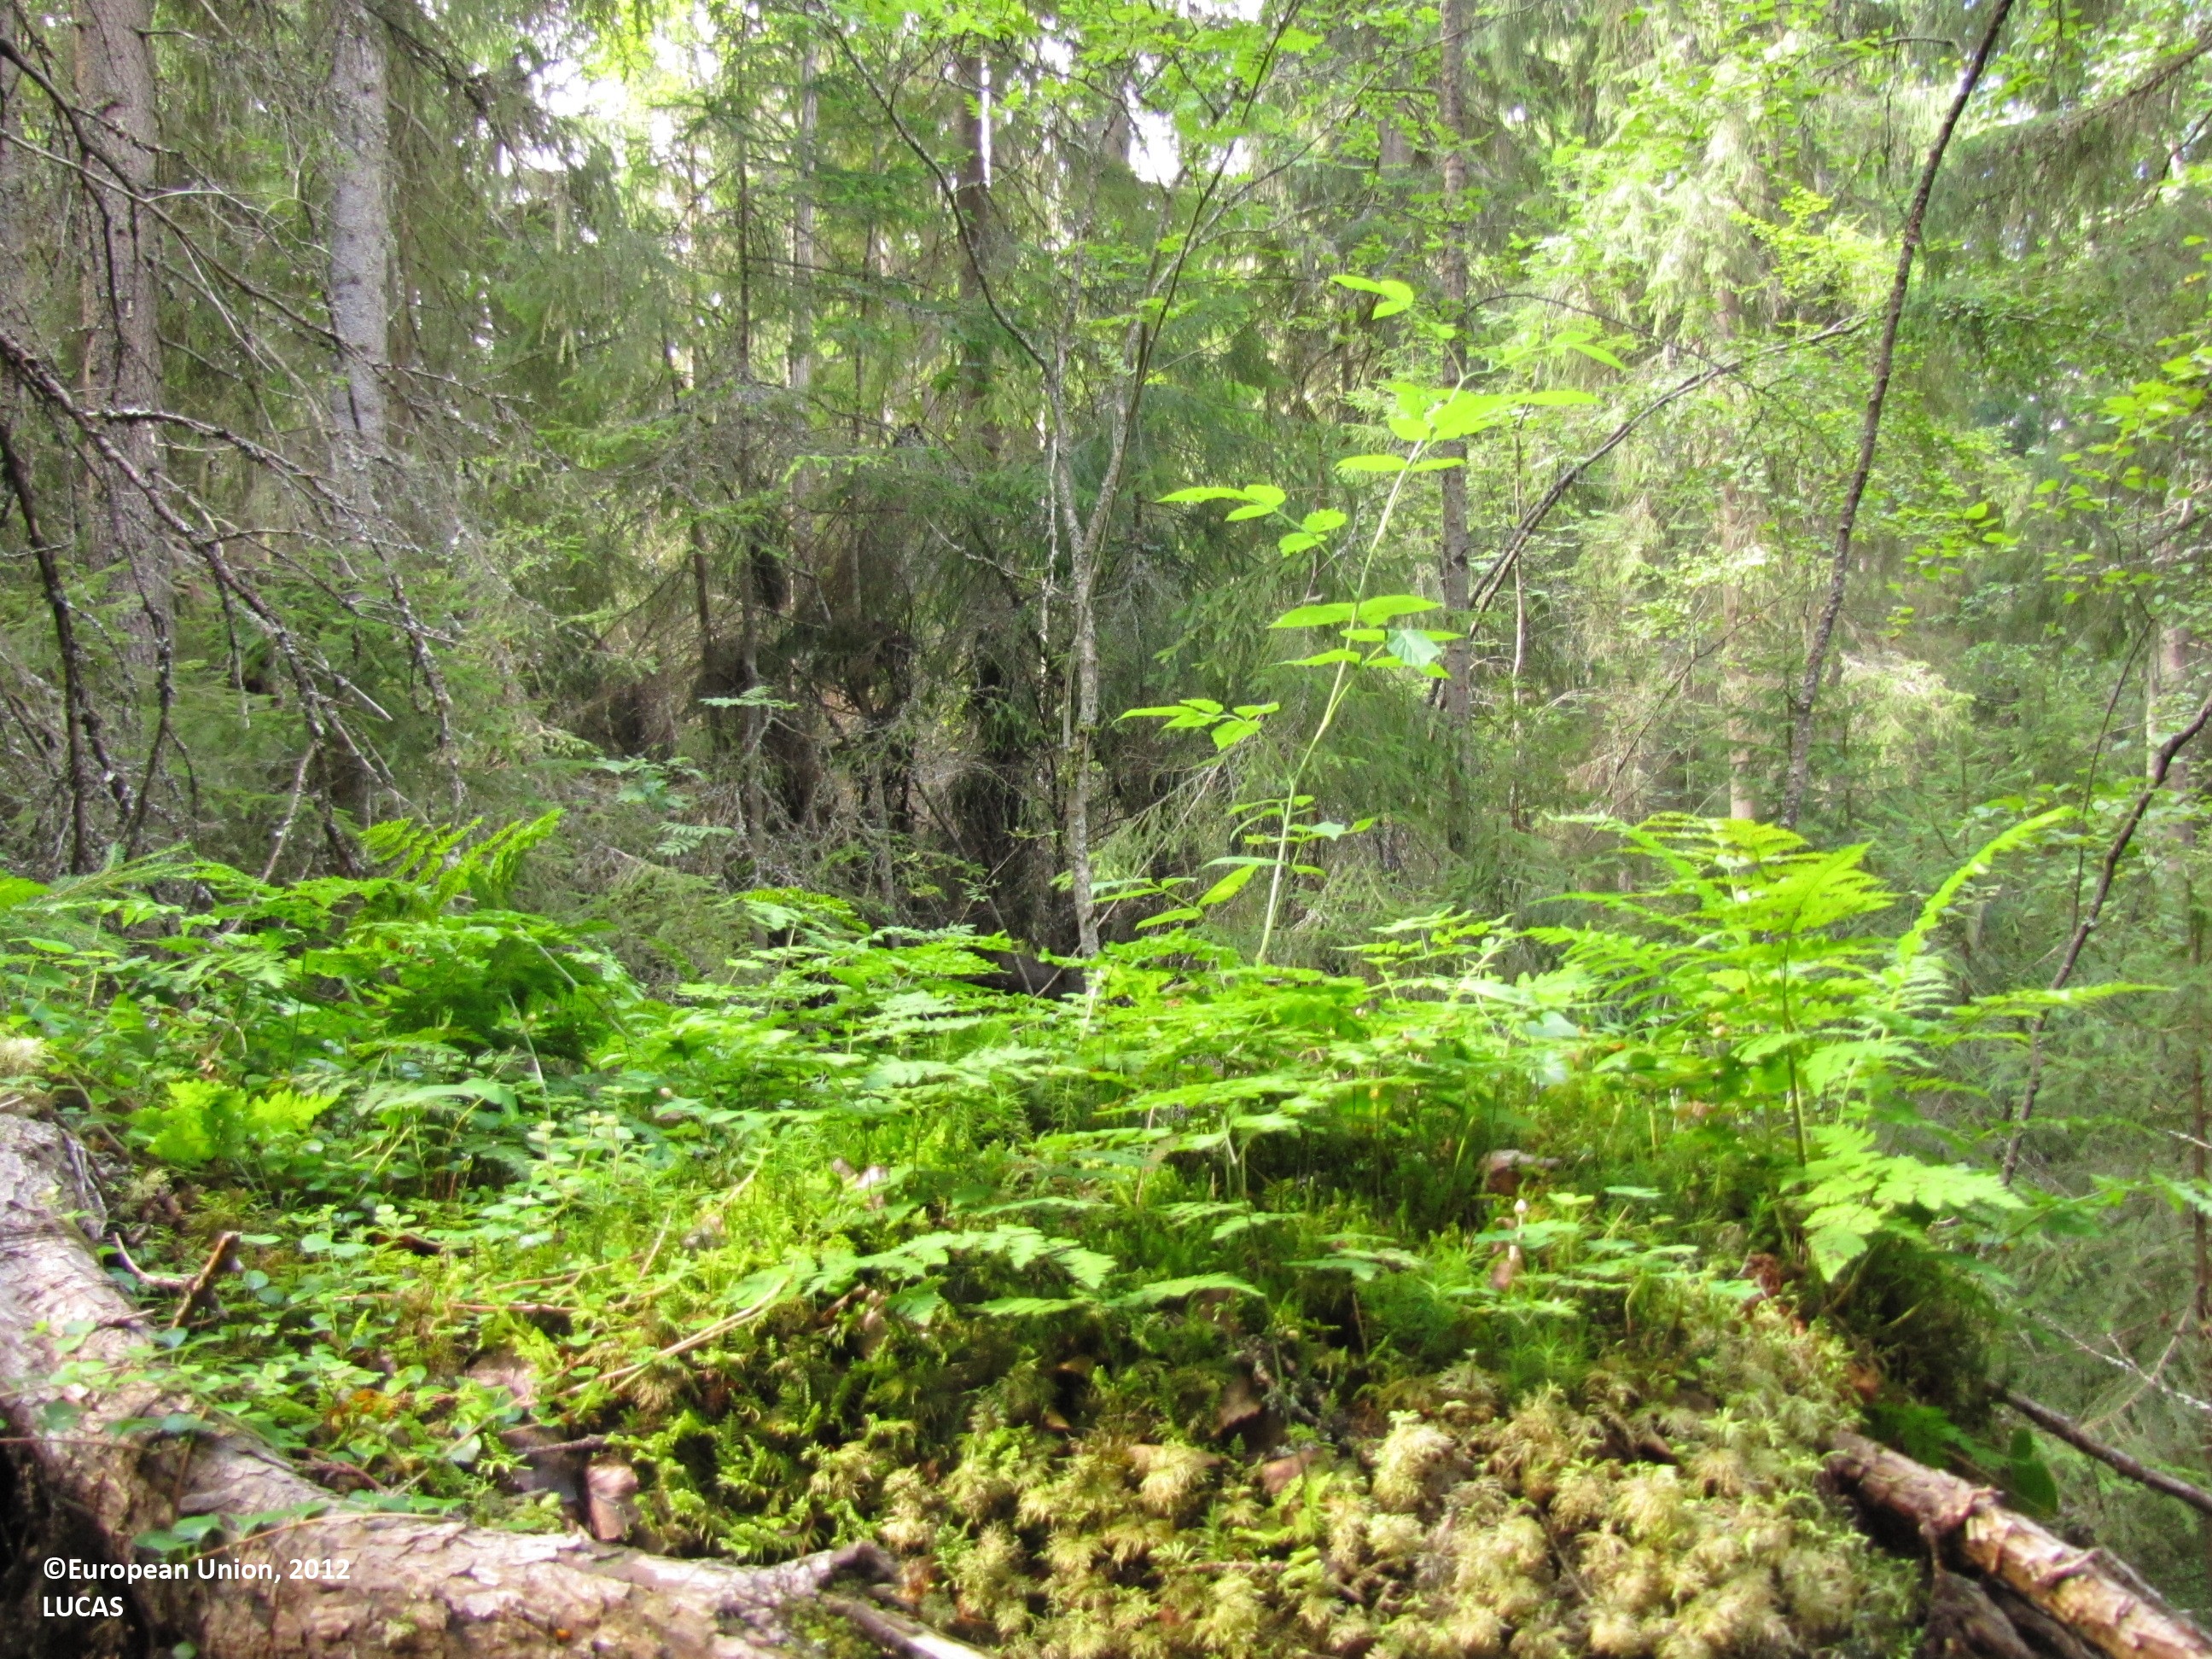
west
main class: Woodland
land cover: Spruce dominated coniferous woodland
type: boreal forest
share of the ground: 50 - 75 %
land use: Forestry
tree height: > 5 m
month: August
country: FI
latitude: 61.7390
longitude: 23.1537
